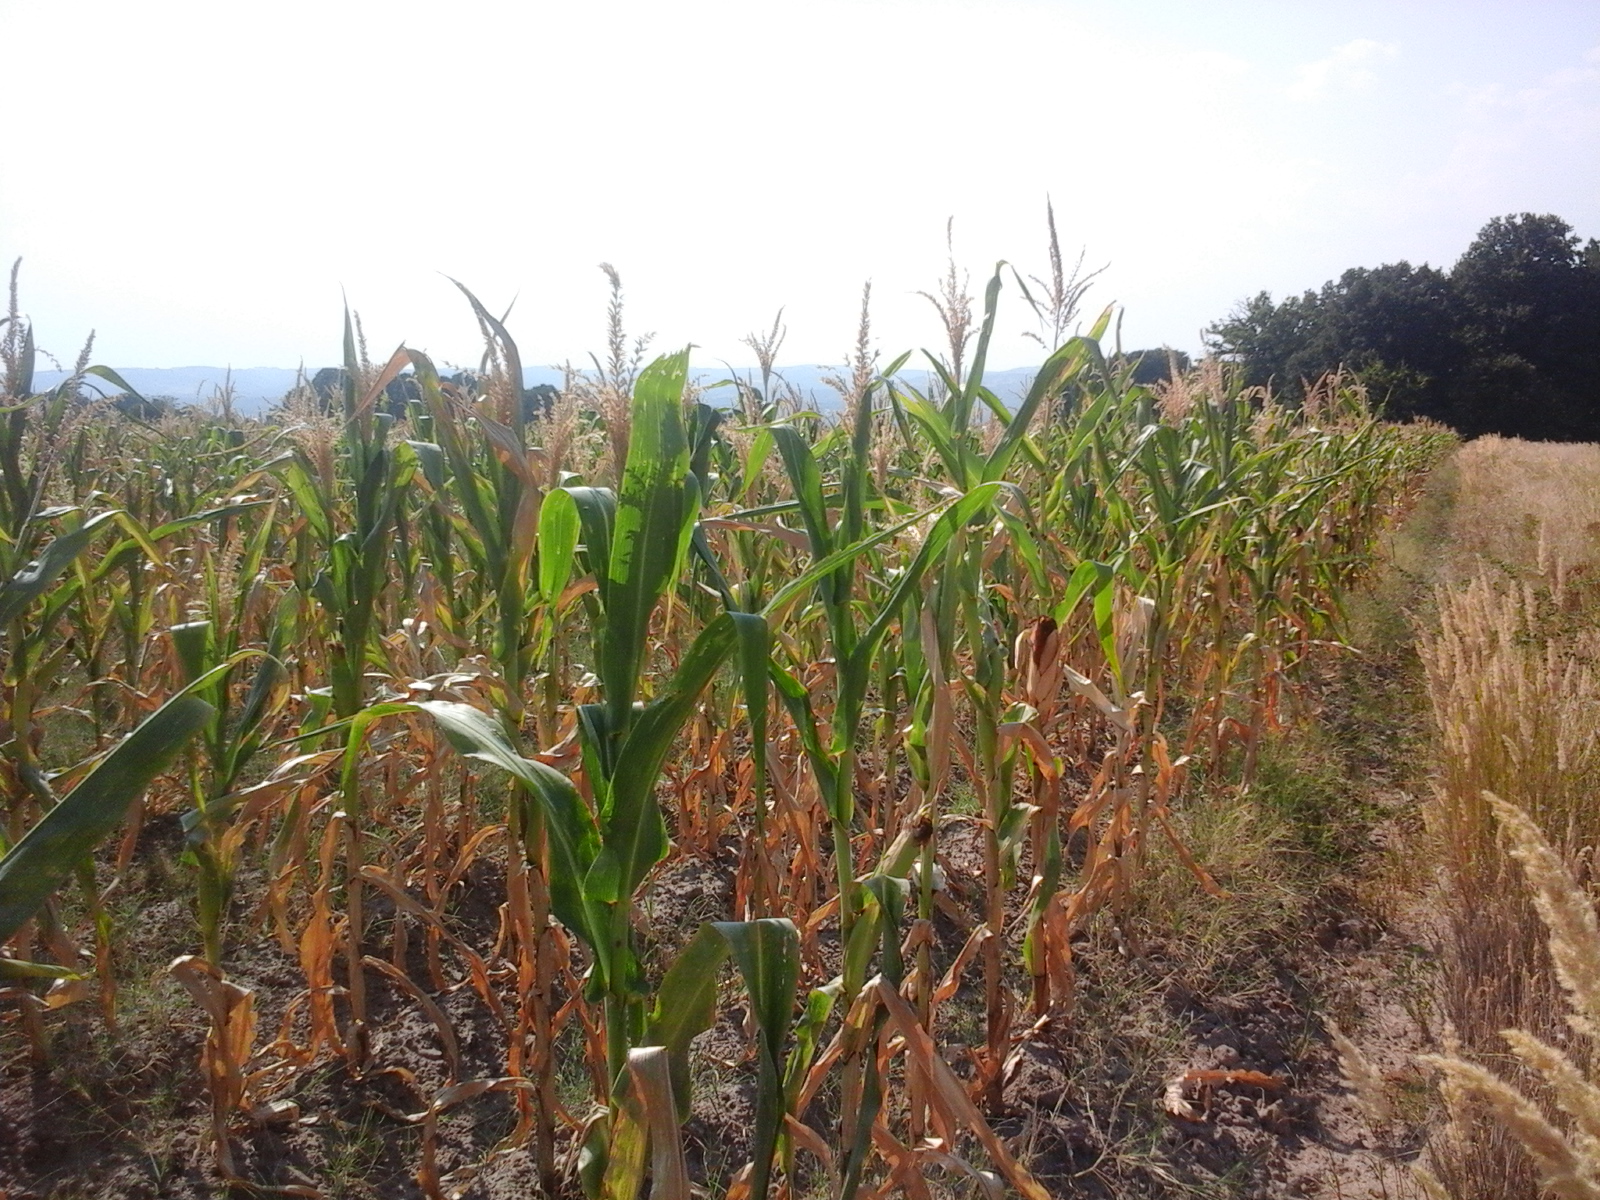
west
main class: Cropland
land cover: Maize
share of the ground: > 75 %
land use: Agriculture (excluding fallow land and kitchen gardens)
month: August
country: RO
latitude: 44.4672
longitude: 22.4948
